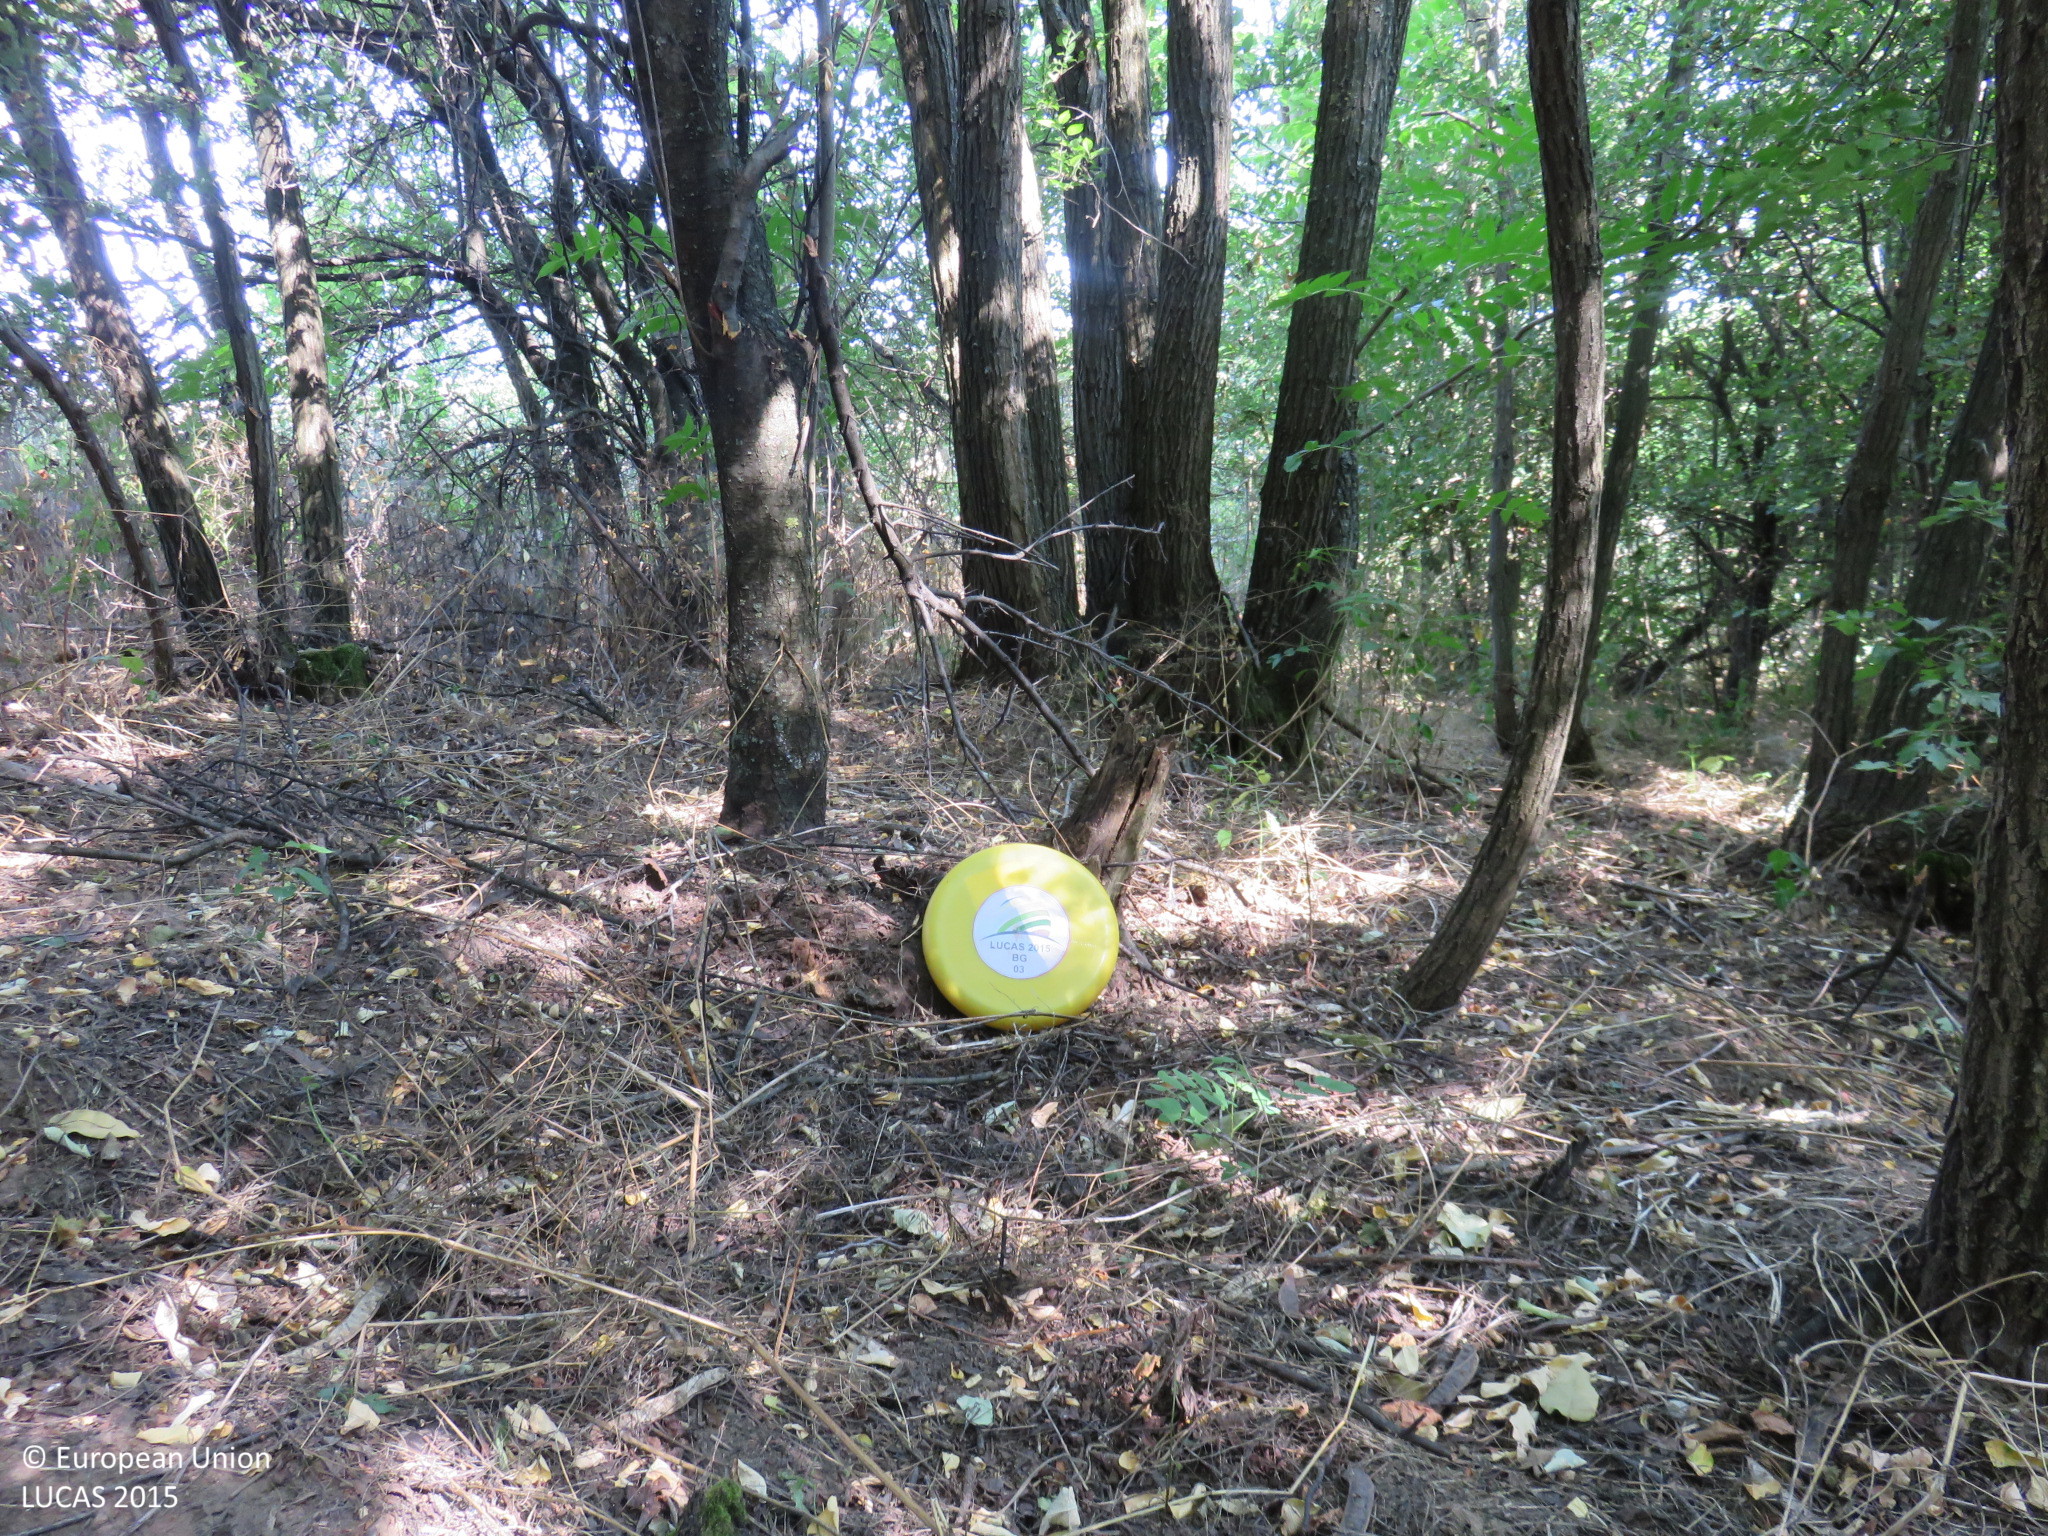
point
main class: Woodland
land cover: Broadleaved woodland
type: mesophytic deciduous forest
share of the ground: > 75 %
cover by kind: broadleaved forest trees 95 %, shrubs 5 %
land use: Forestry
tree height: > 5 m
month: July
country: BG
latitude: 43.5228
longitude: 25.1562
